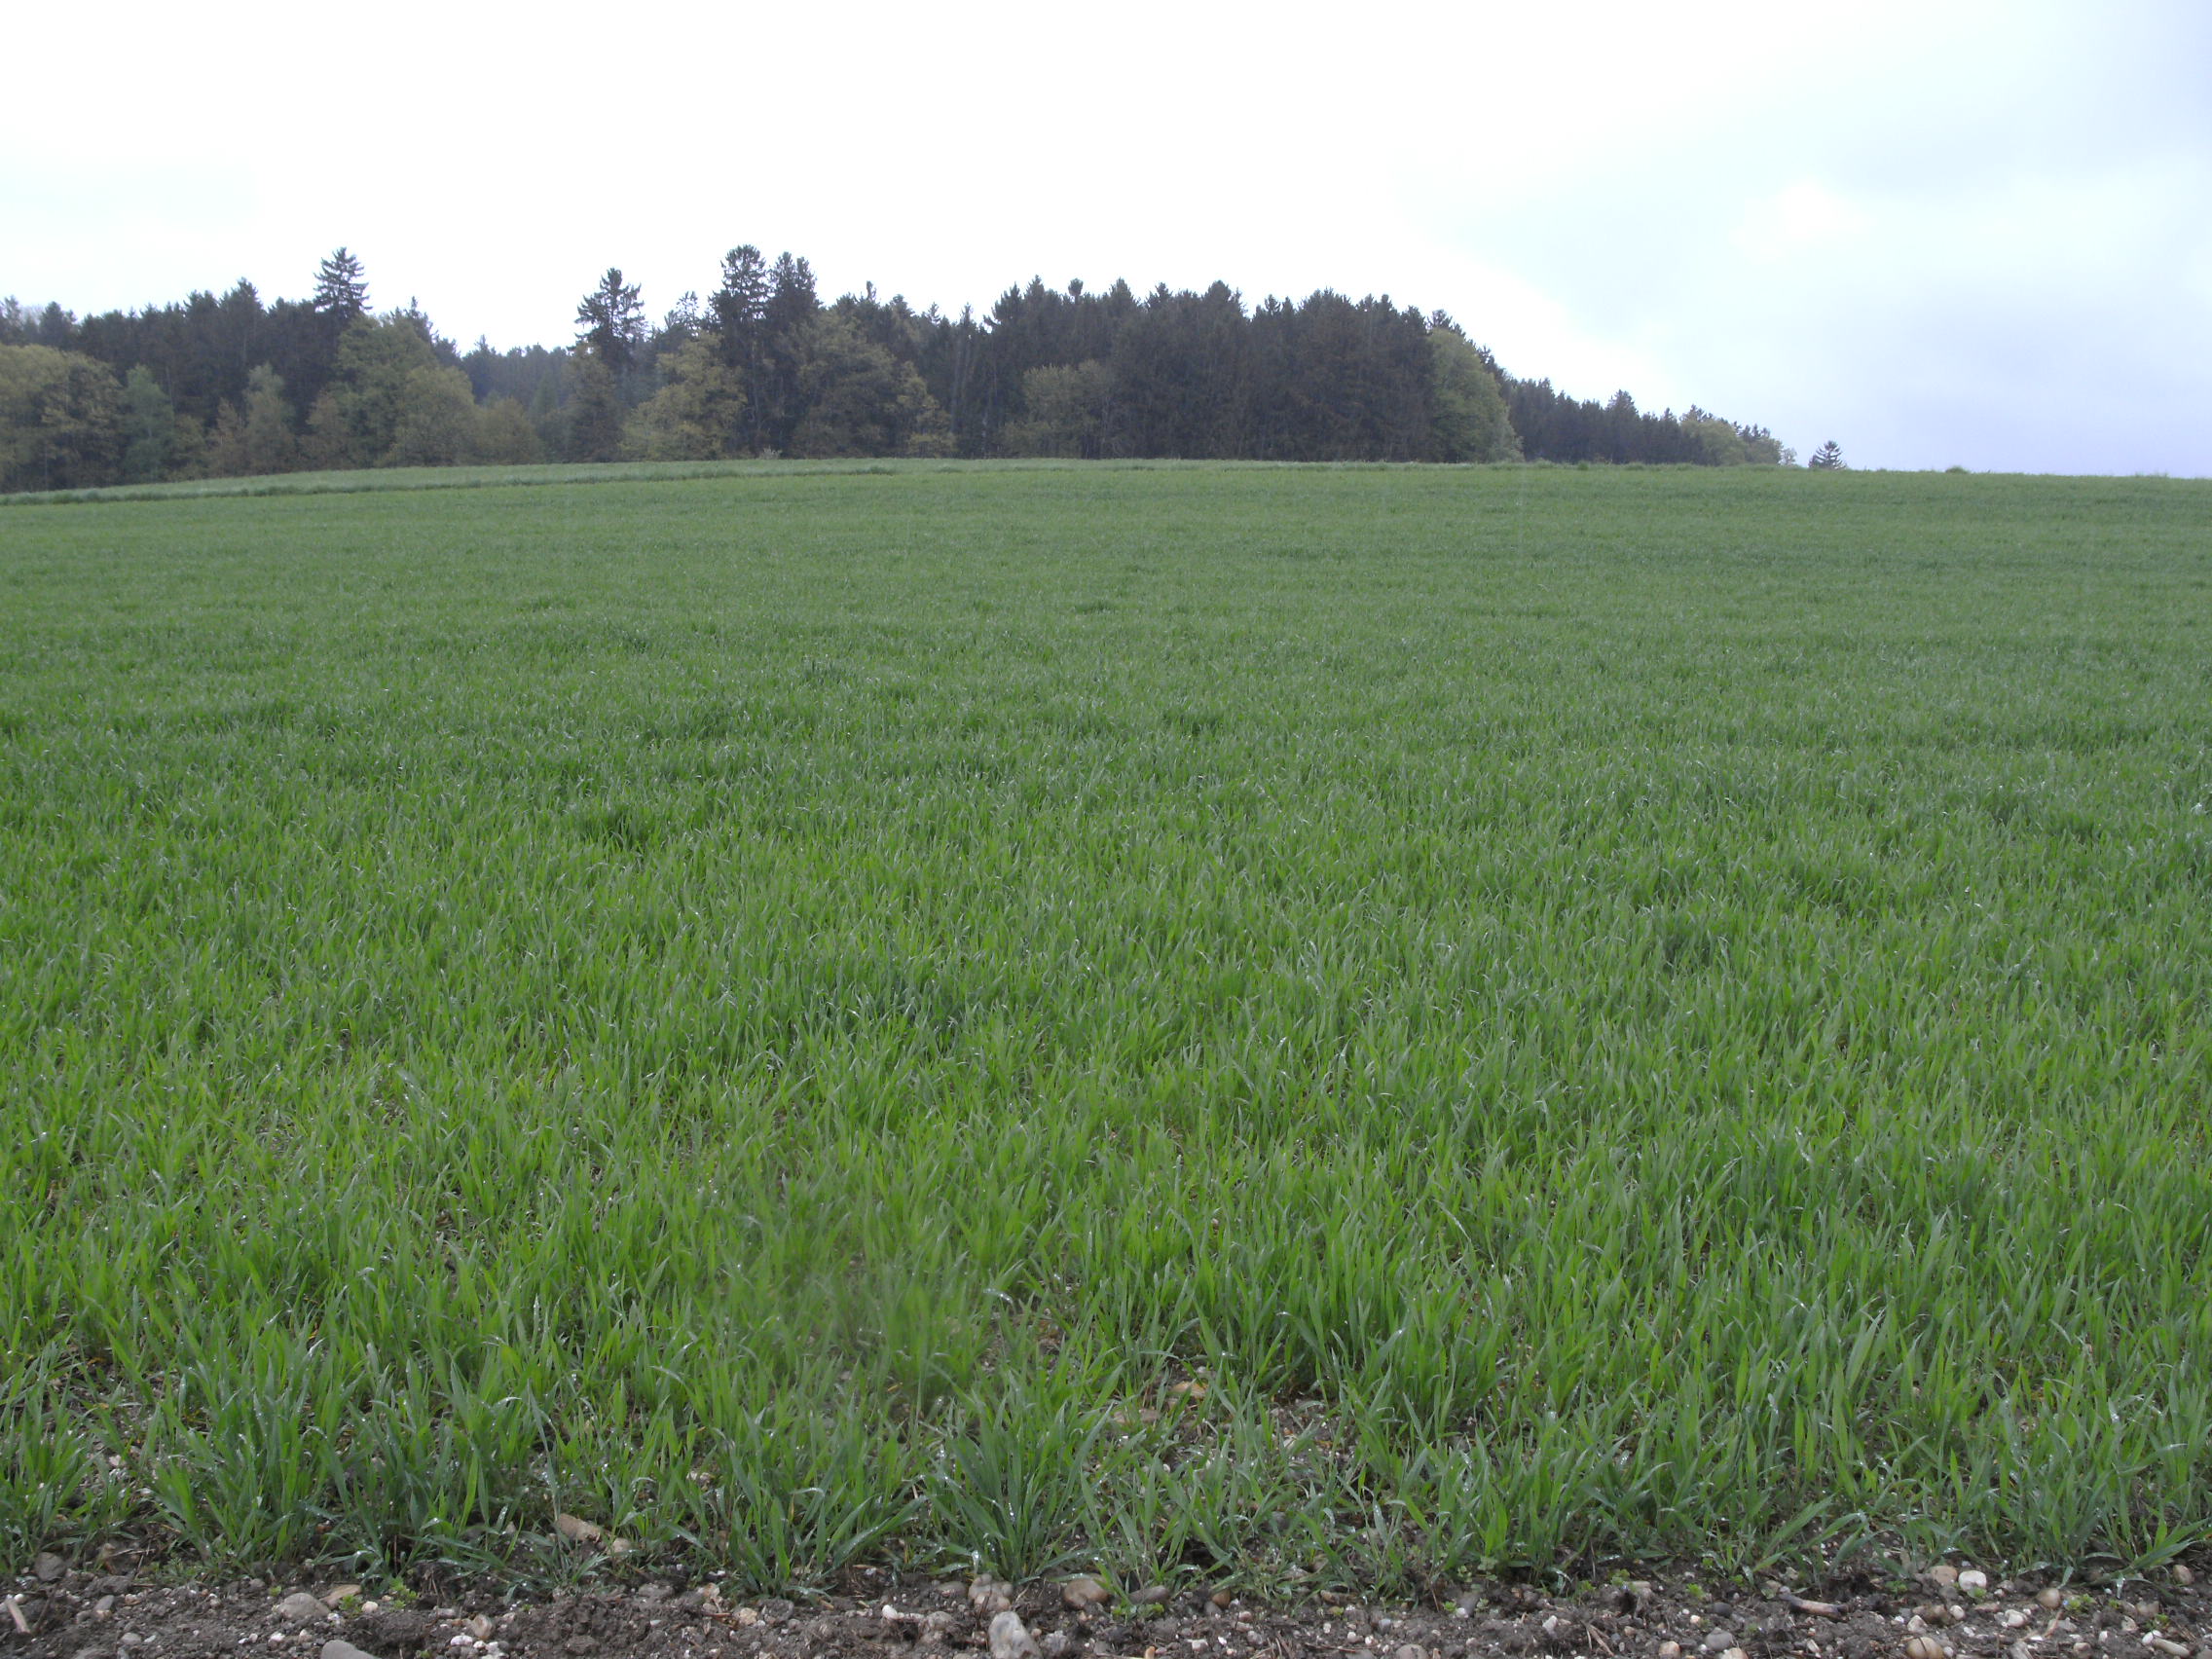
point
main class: Cropland
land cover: Common wheat
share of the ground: > 75 %
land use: Agriculture (excluding fallow land and kitchen gardens)
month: May
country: AT
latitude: 48.1840
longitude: 13.5636
